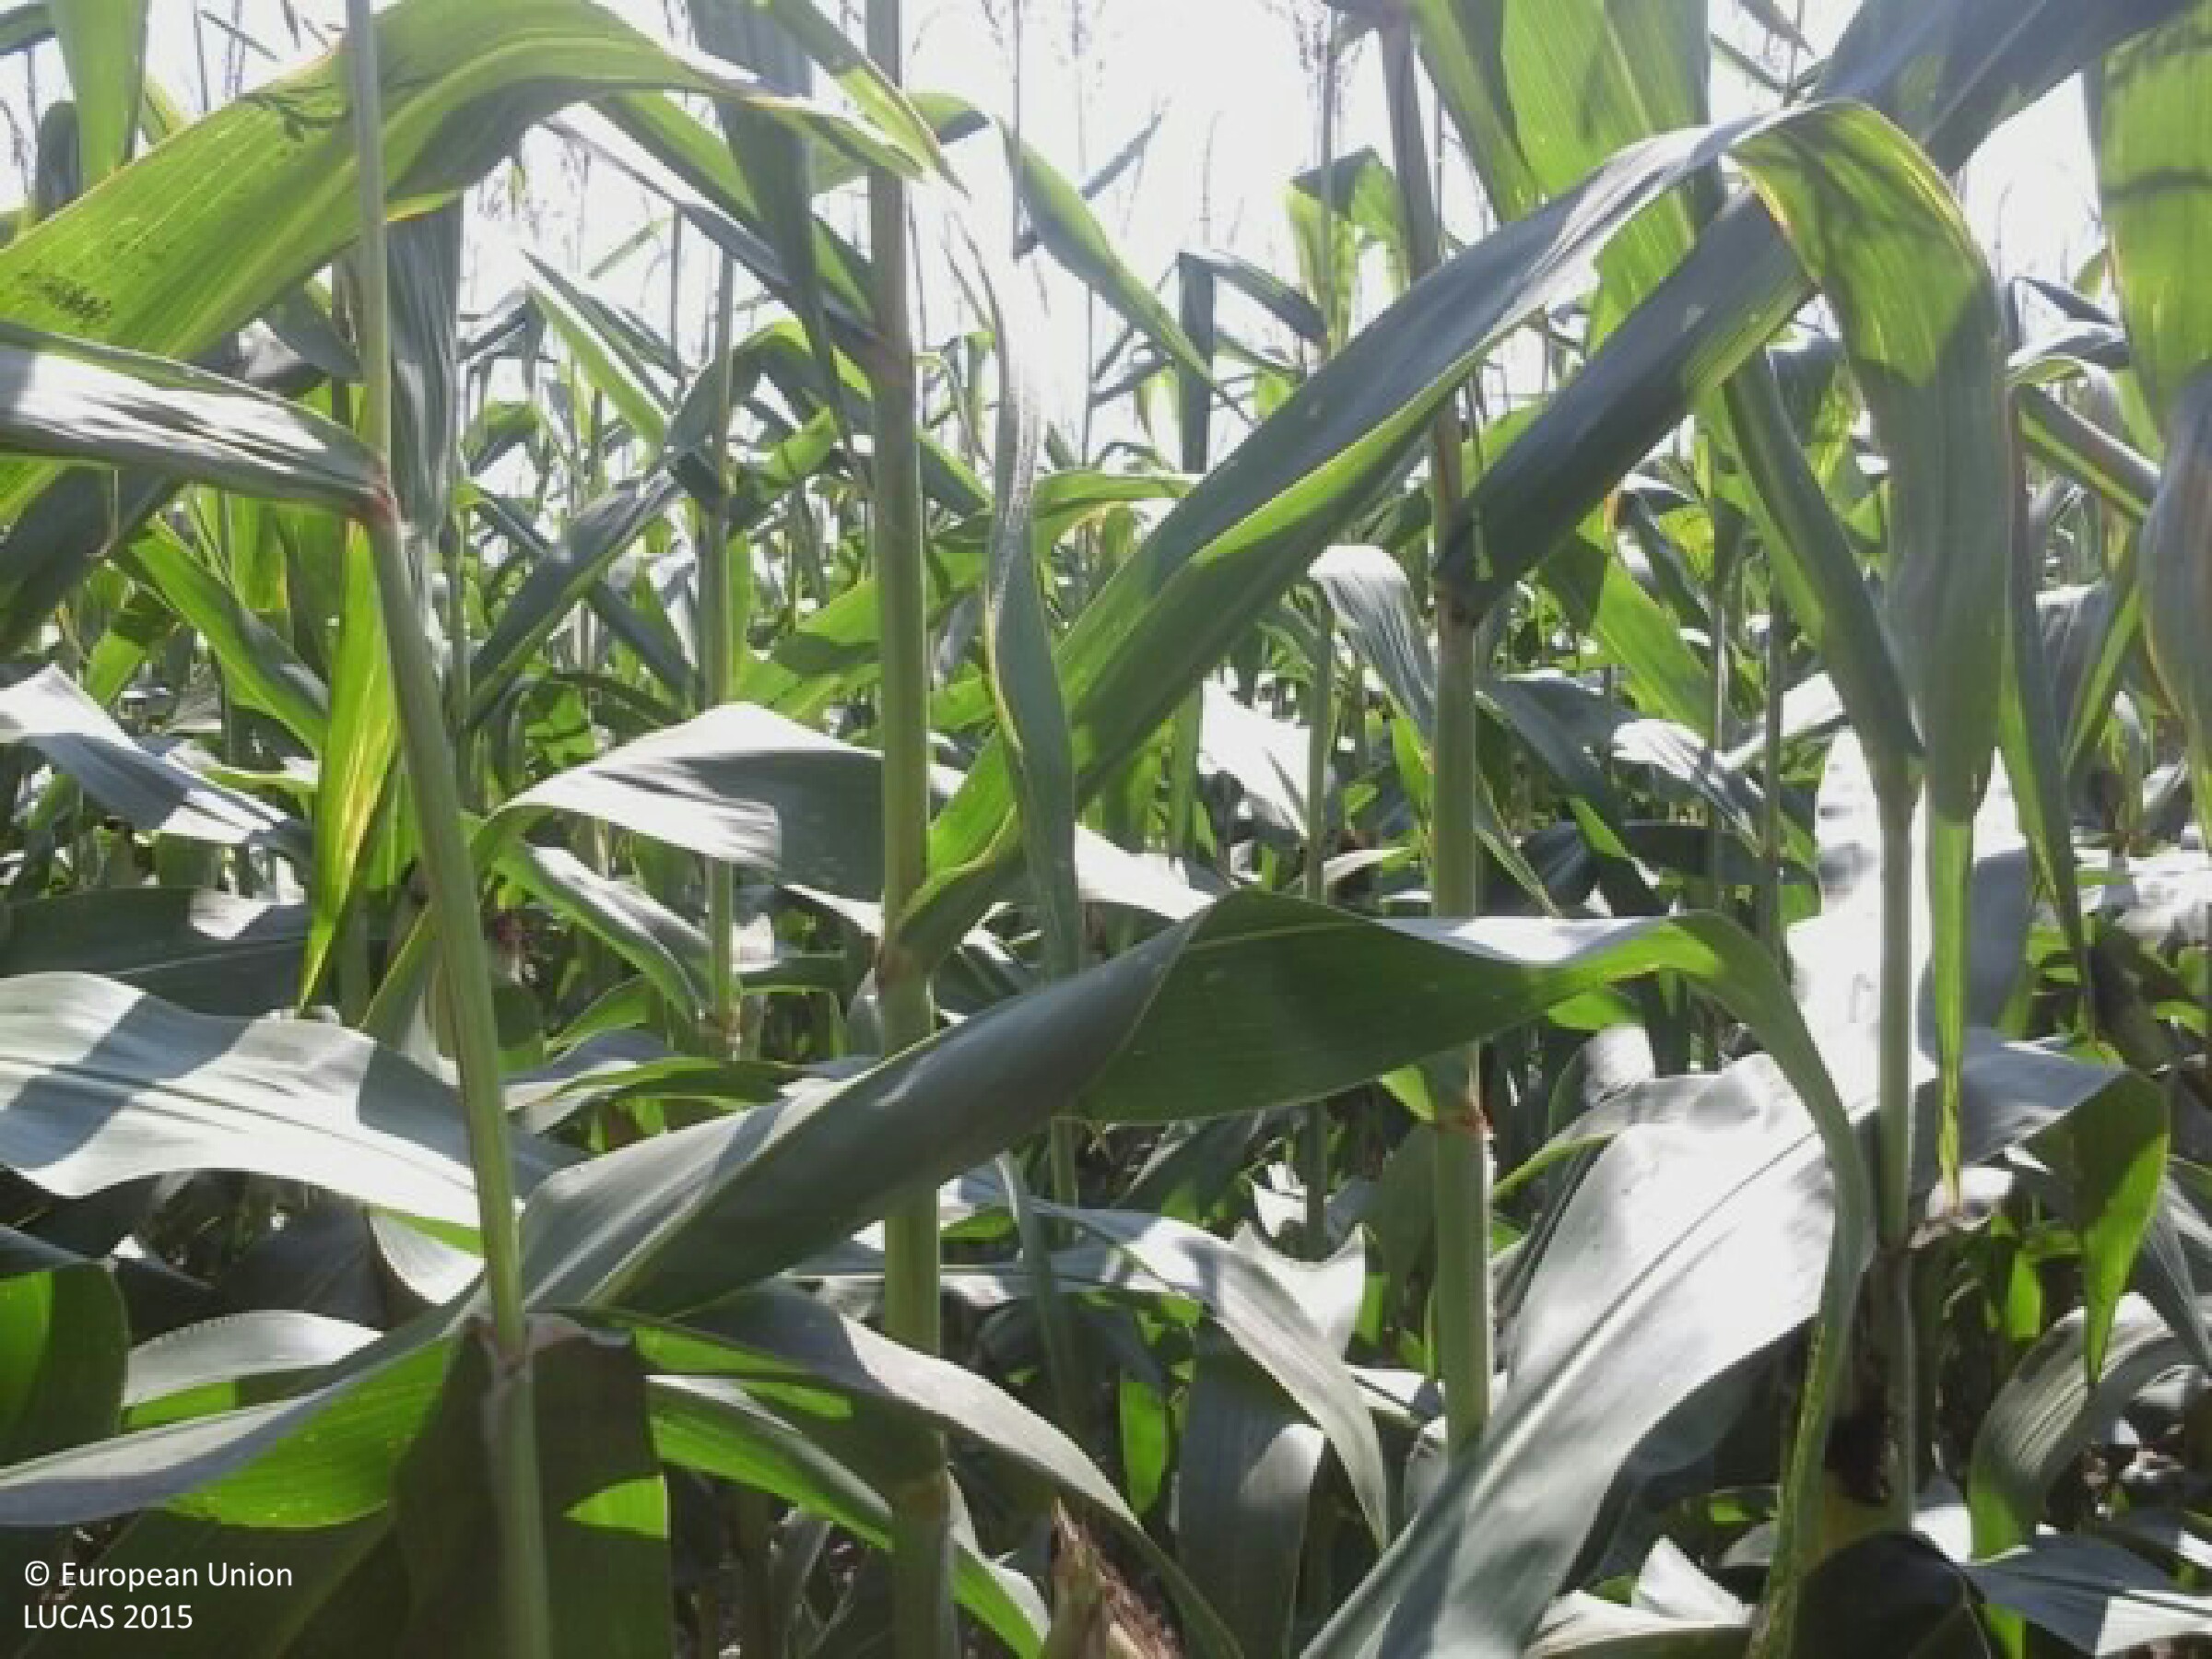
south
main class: Cropland
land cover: Maize
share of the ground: > 75 %
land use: Agriculture (excluding fallow land and kitchen gardens)
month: August
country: HU
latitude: 46.7160
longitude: 18.9755
